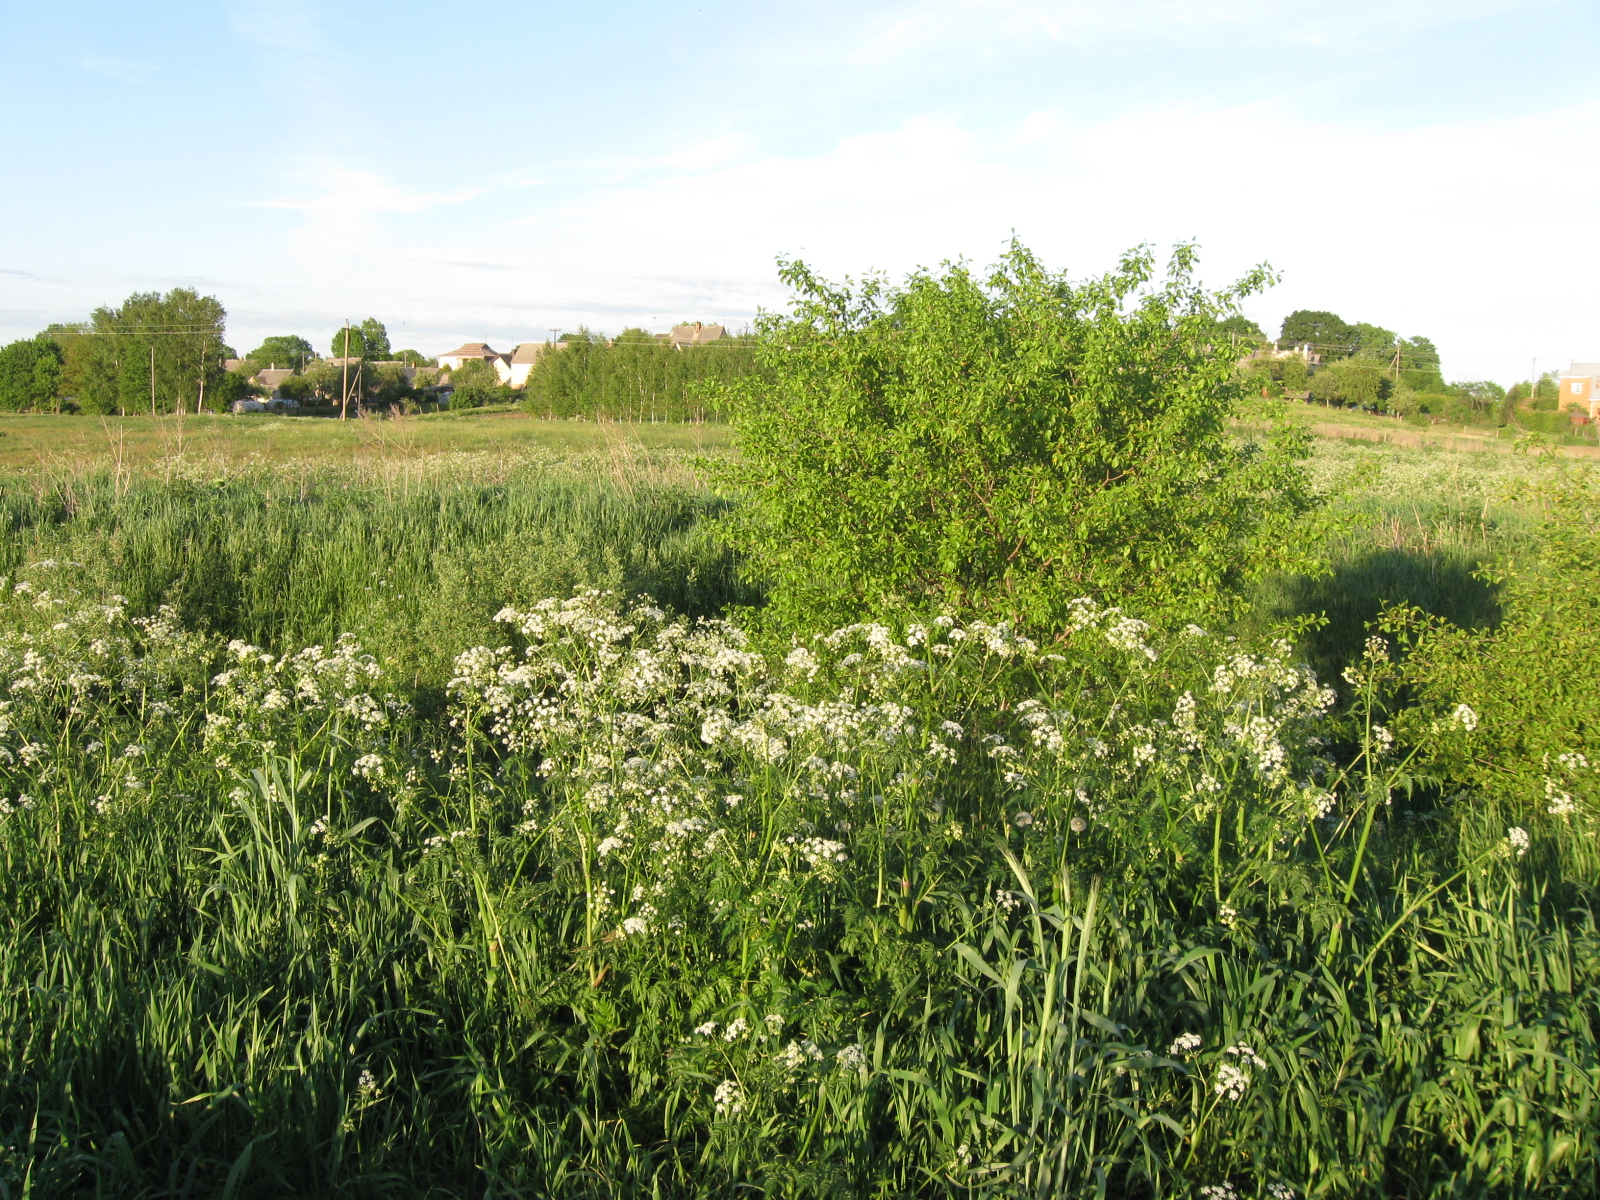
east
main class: Cropland
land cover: Common wheat
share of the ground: > 75 %
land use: Agriculture (excluding fallow land and kitchen gardens)
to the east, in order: Common wheat; Grassland with sparse tree/shrub cover; Ditches and canals; Grassland with sparse tree/shrub cover; Spontaneously vegetated surfaces; Grassland without tree/shrub cover; Tracks; Grassland without tree/shrub cover; Electric lines; Grassland without tree/shrub cover; Ditches and canals; Broadleaved woodland; Grassland without tree/shrub cover; Cherry fruit; Strawberries; Potatoes; Artificial constructions in urban areas
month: May
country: LT
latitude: 54.2282
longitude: 23.5048
